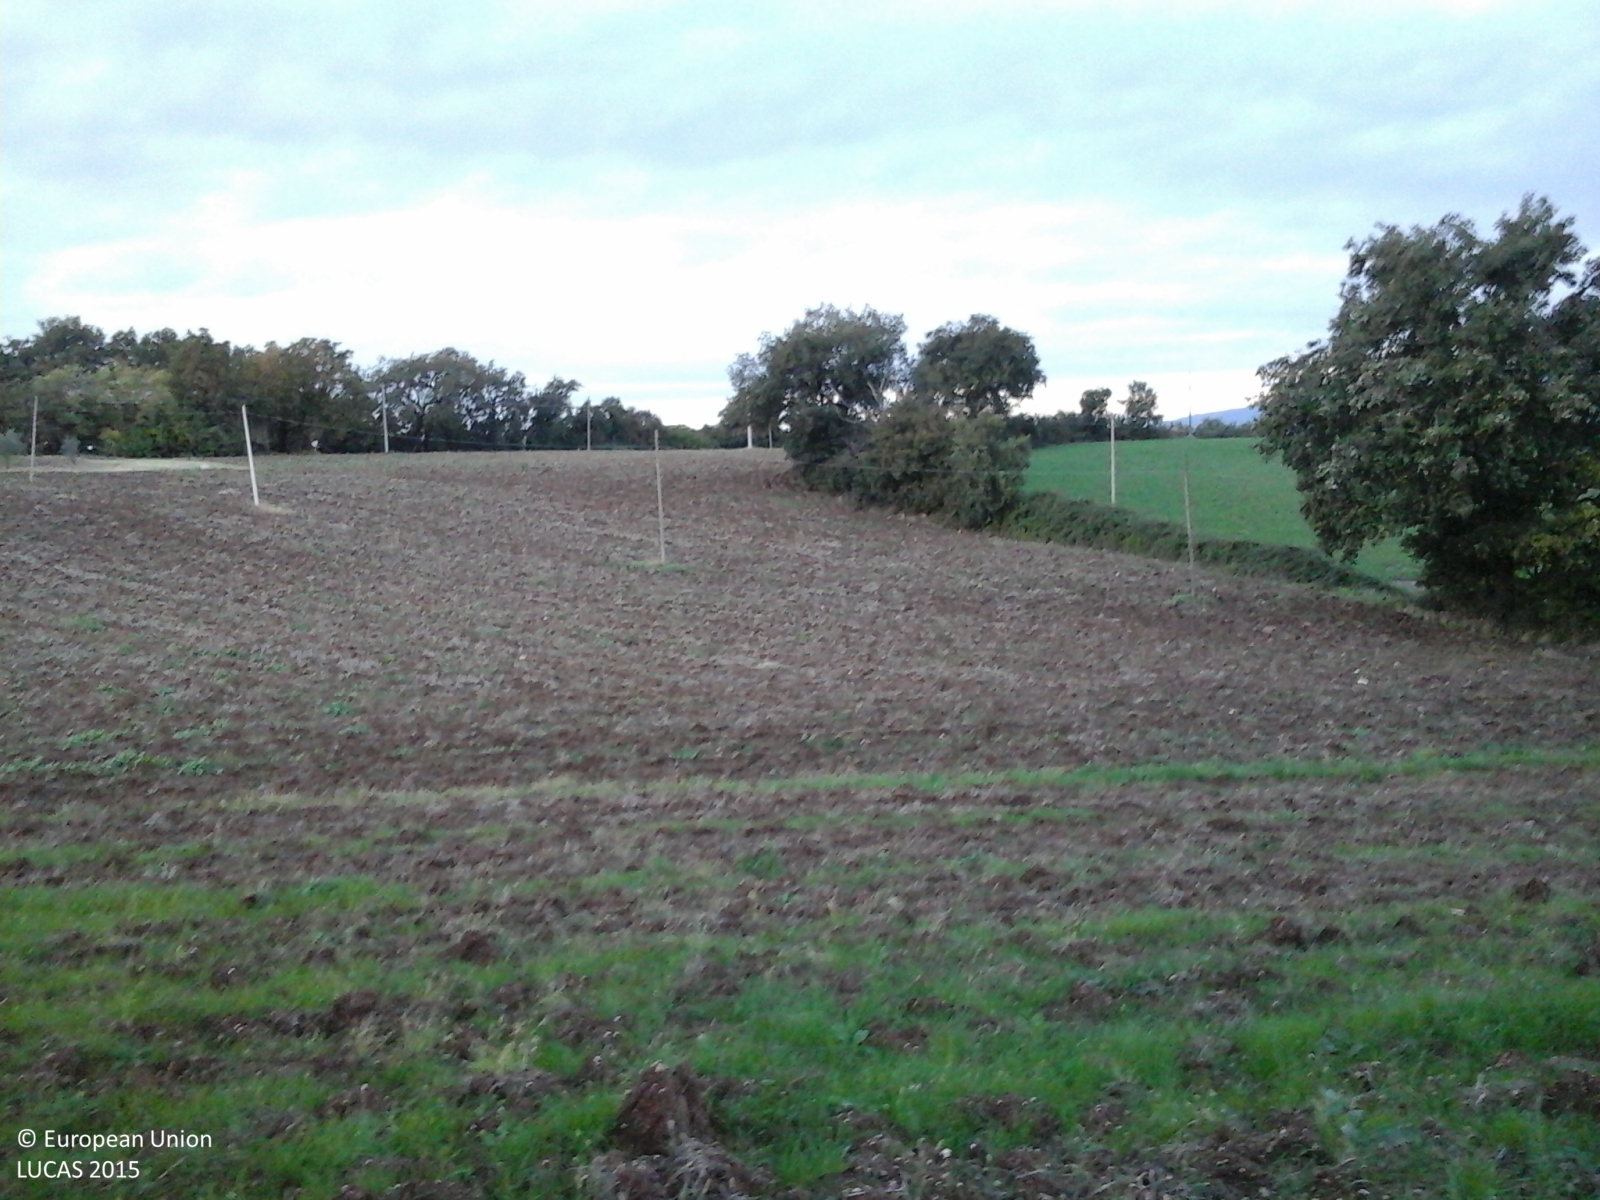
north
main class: Cropland
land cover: Common wheat
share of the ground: < 10 %
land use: Agriculture (excluding fallow land and kitchen gardens)
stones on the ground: < 10 %
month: October
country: IT
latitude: 42.6763
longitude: 12.5424
